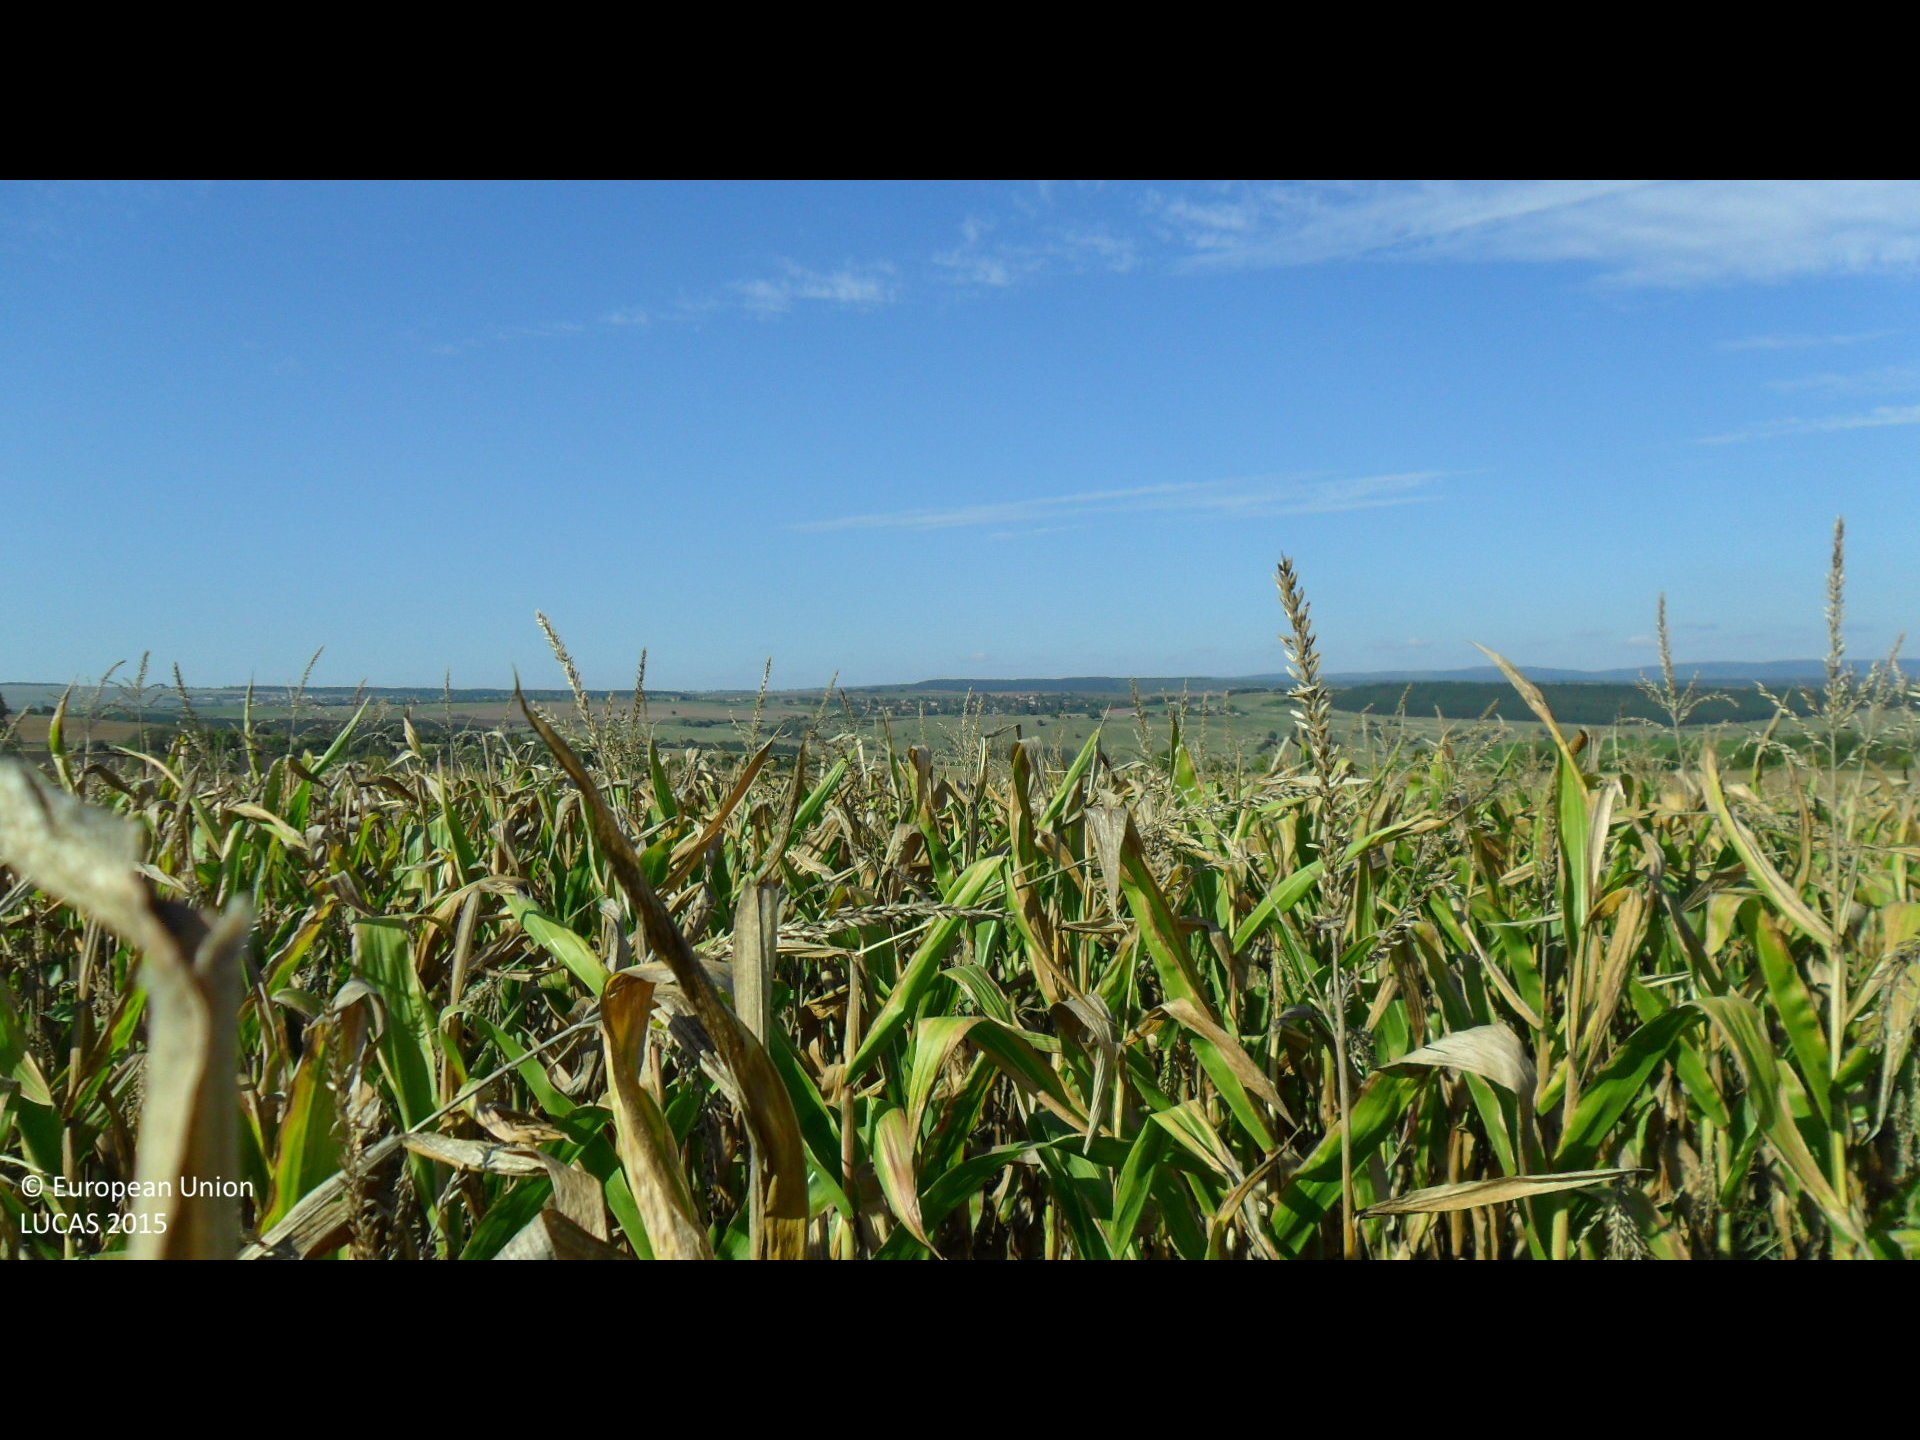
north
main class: Cropland
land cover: Maize
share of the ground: > 75 %
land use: Agriculture (excluding fallow land and kitchen gardens)
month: September
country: BG
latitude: 43.0236
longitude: 26.5814
